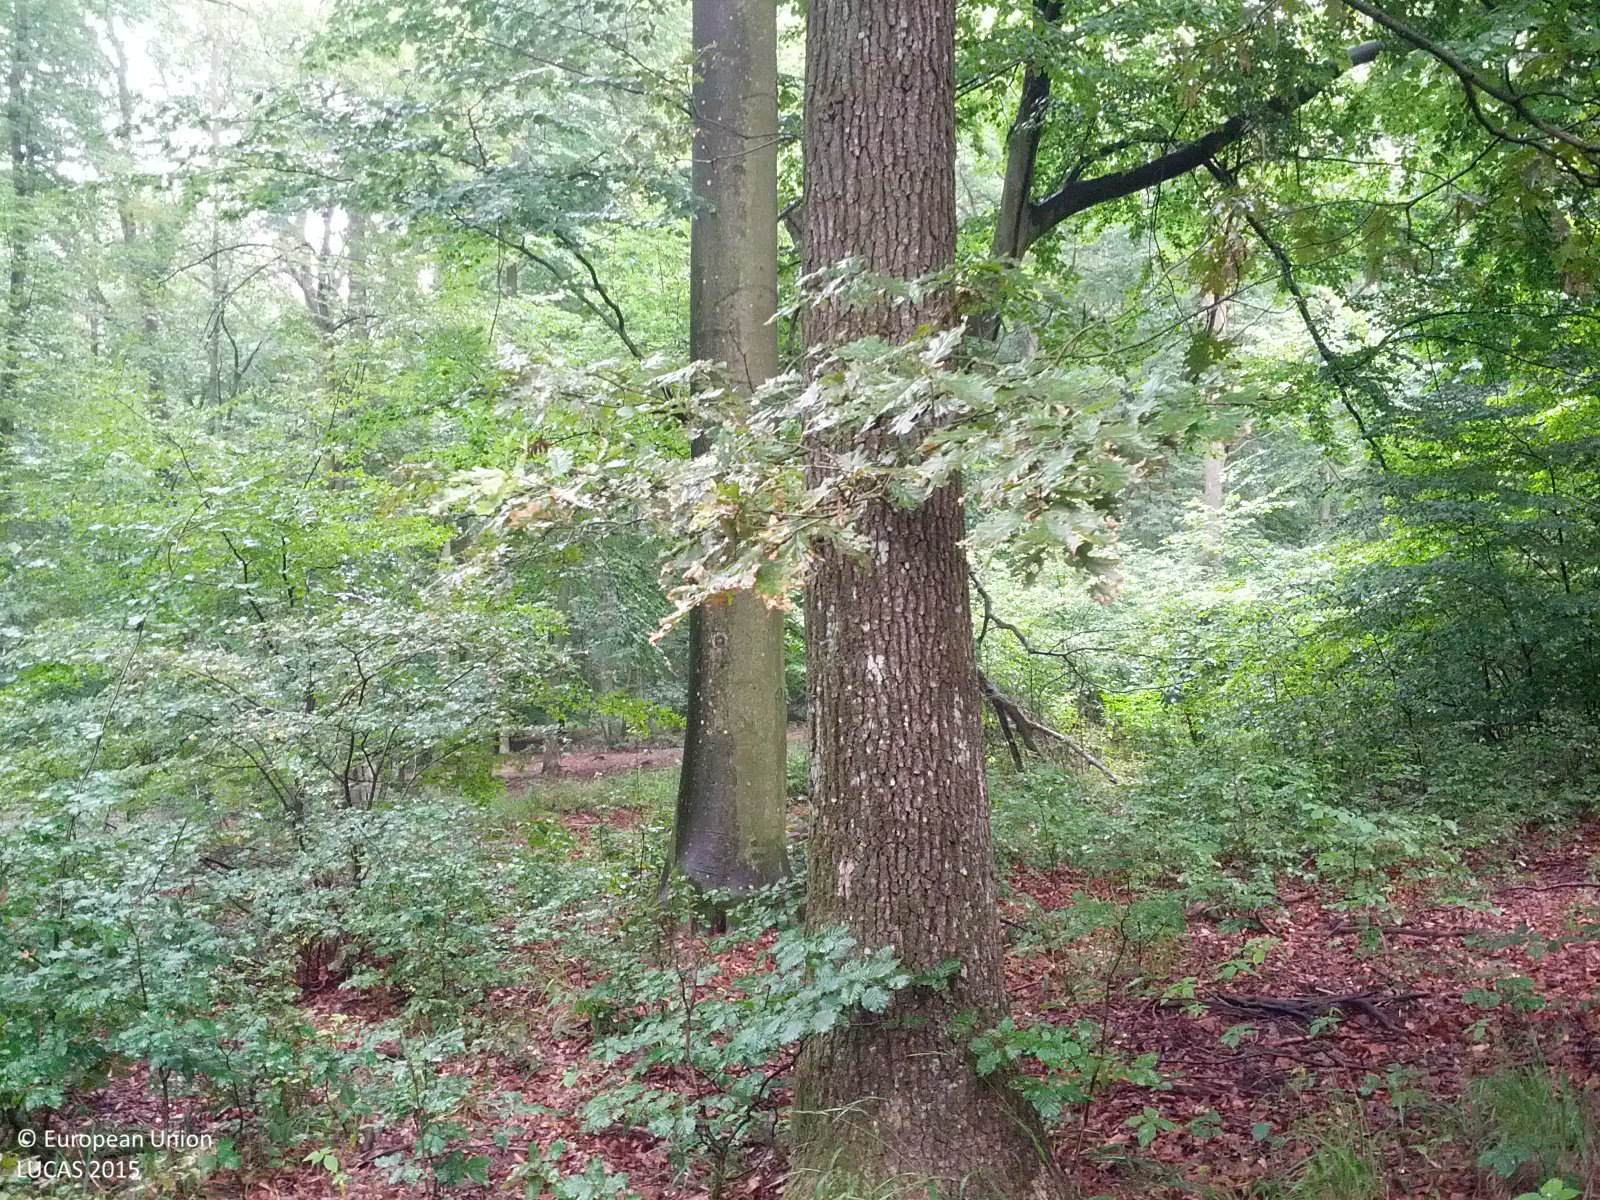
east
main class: Woodland
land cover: Broadleaved woodland
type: acidophilous oak and oak-birch forest
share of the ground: > 75 %
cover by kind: broadleaved forest trees 80 %, shrubs 10 %, herbaceous plants 10 %
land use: Forestry
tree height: > 5 m
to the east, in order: Broadleaved woodland; Tracks; Broadleaved woodland
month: July
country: AT
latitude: 48.5469
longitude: 16.3315
